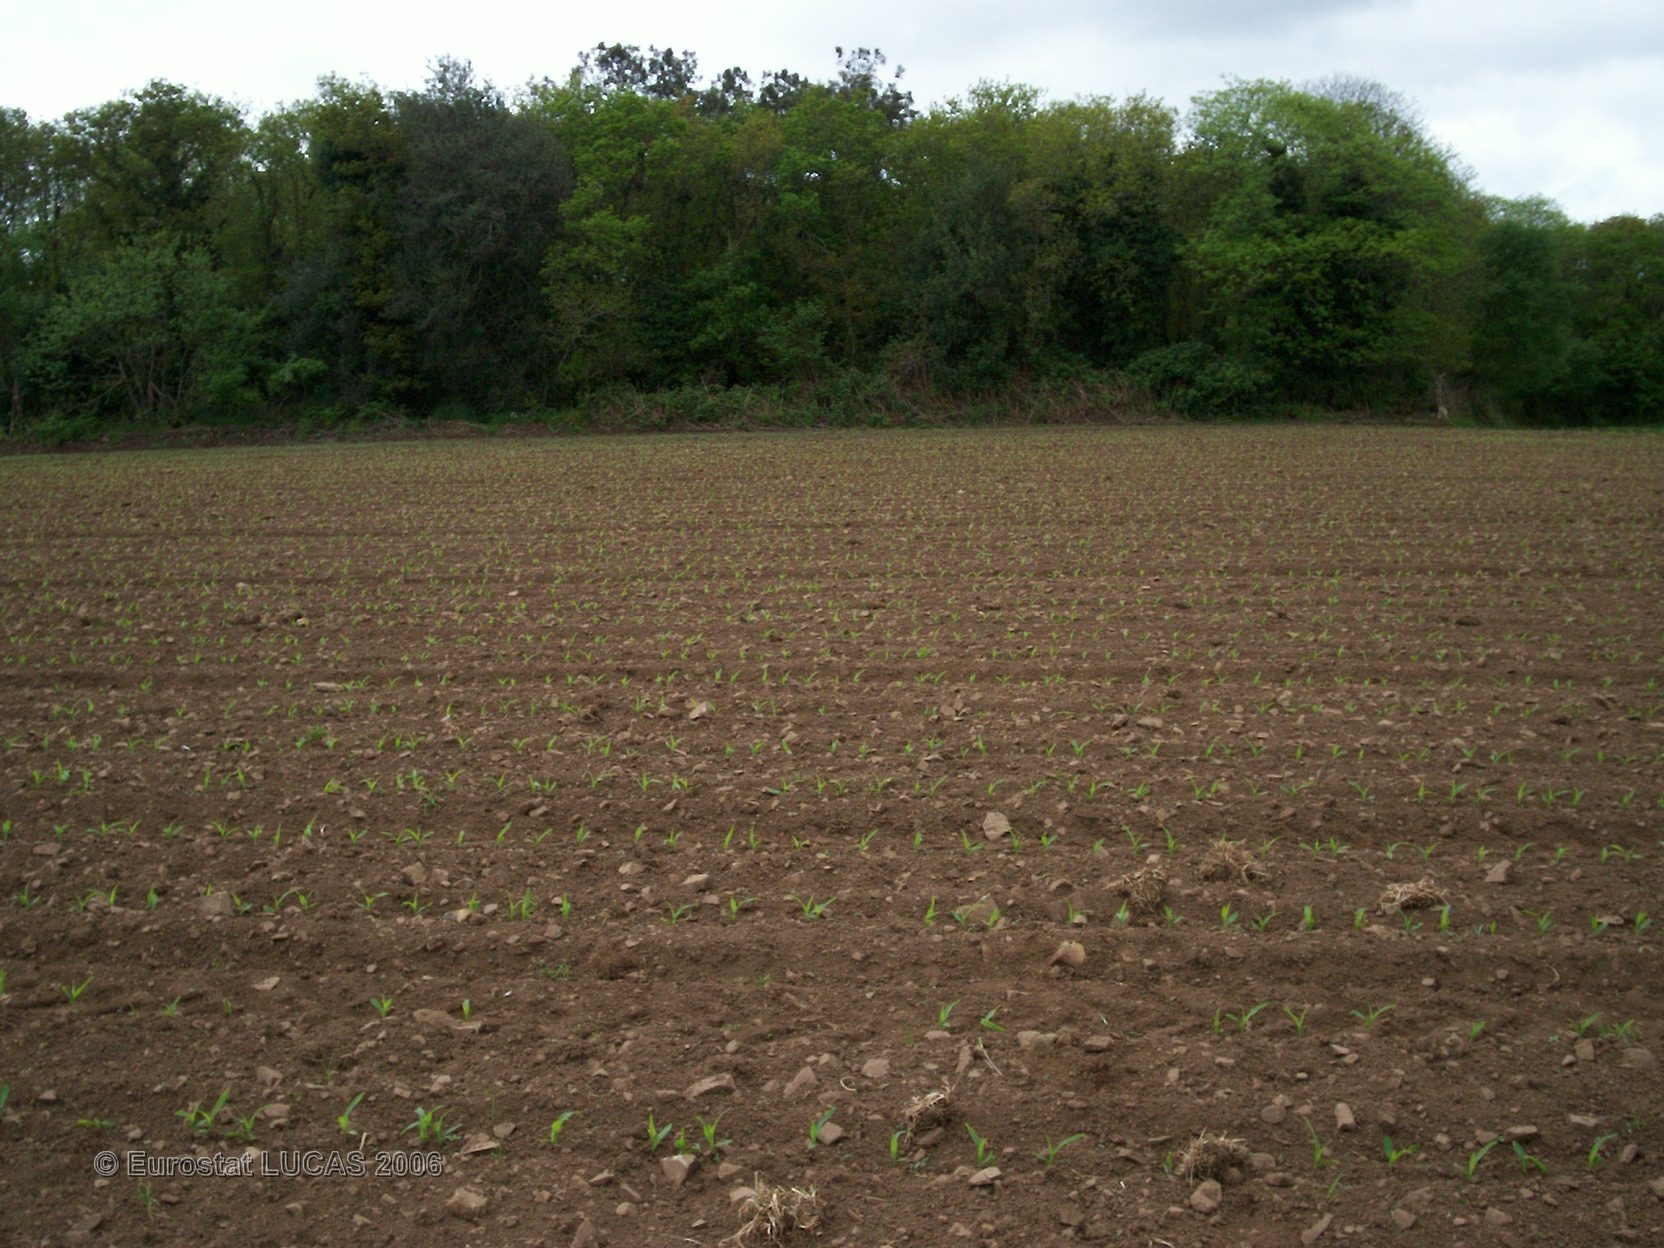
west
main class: Cropland
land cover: Maize
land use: Agriculture (excluding fallow land and kitchen gardens)
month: May
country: FR
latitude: 48.6168
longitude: -3.7440
